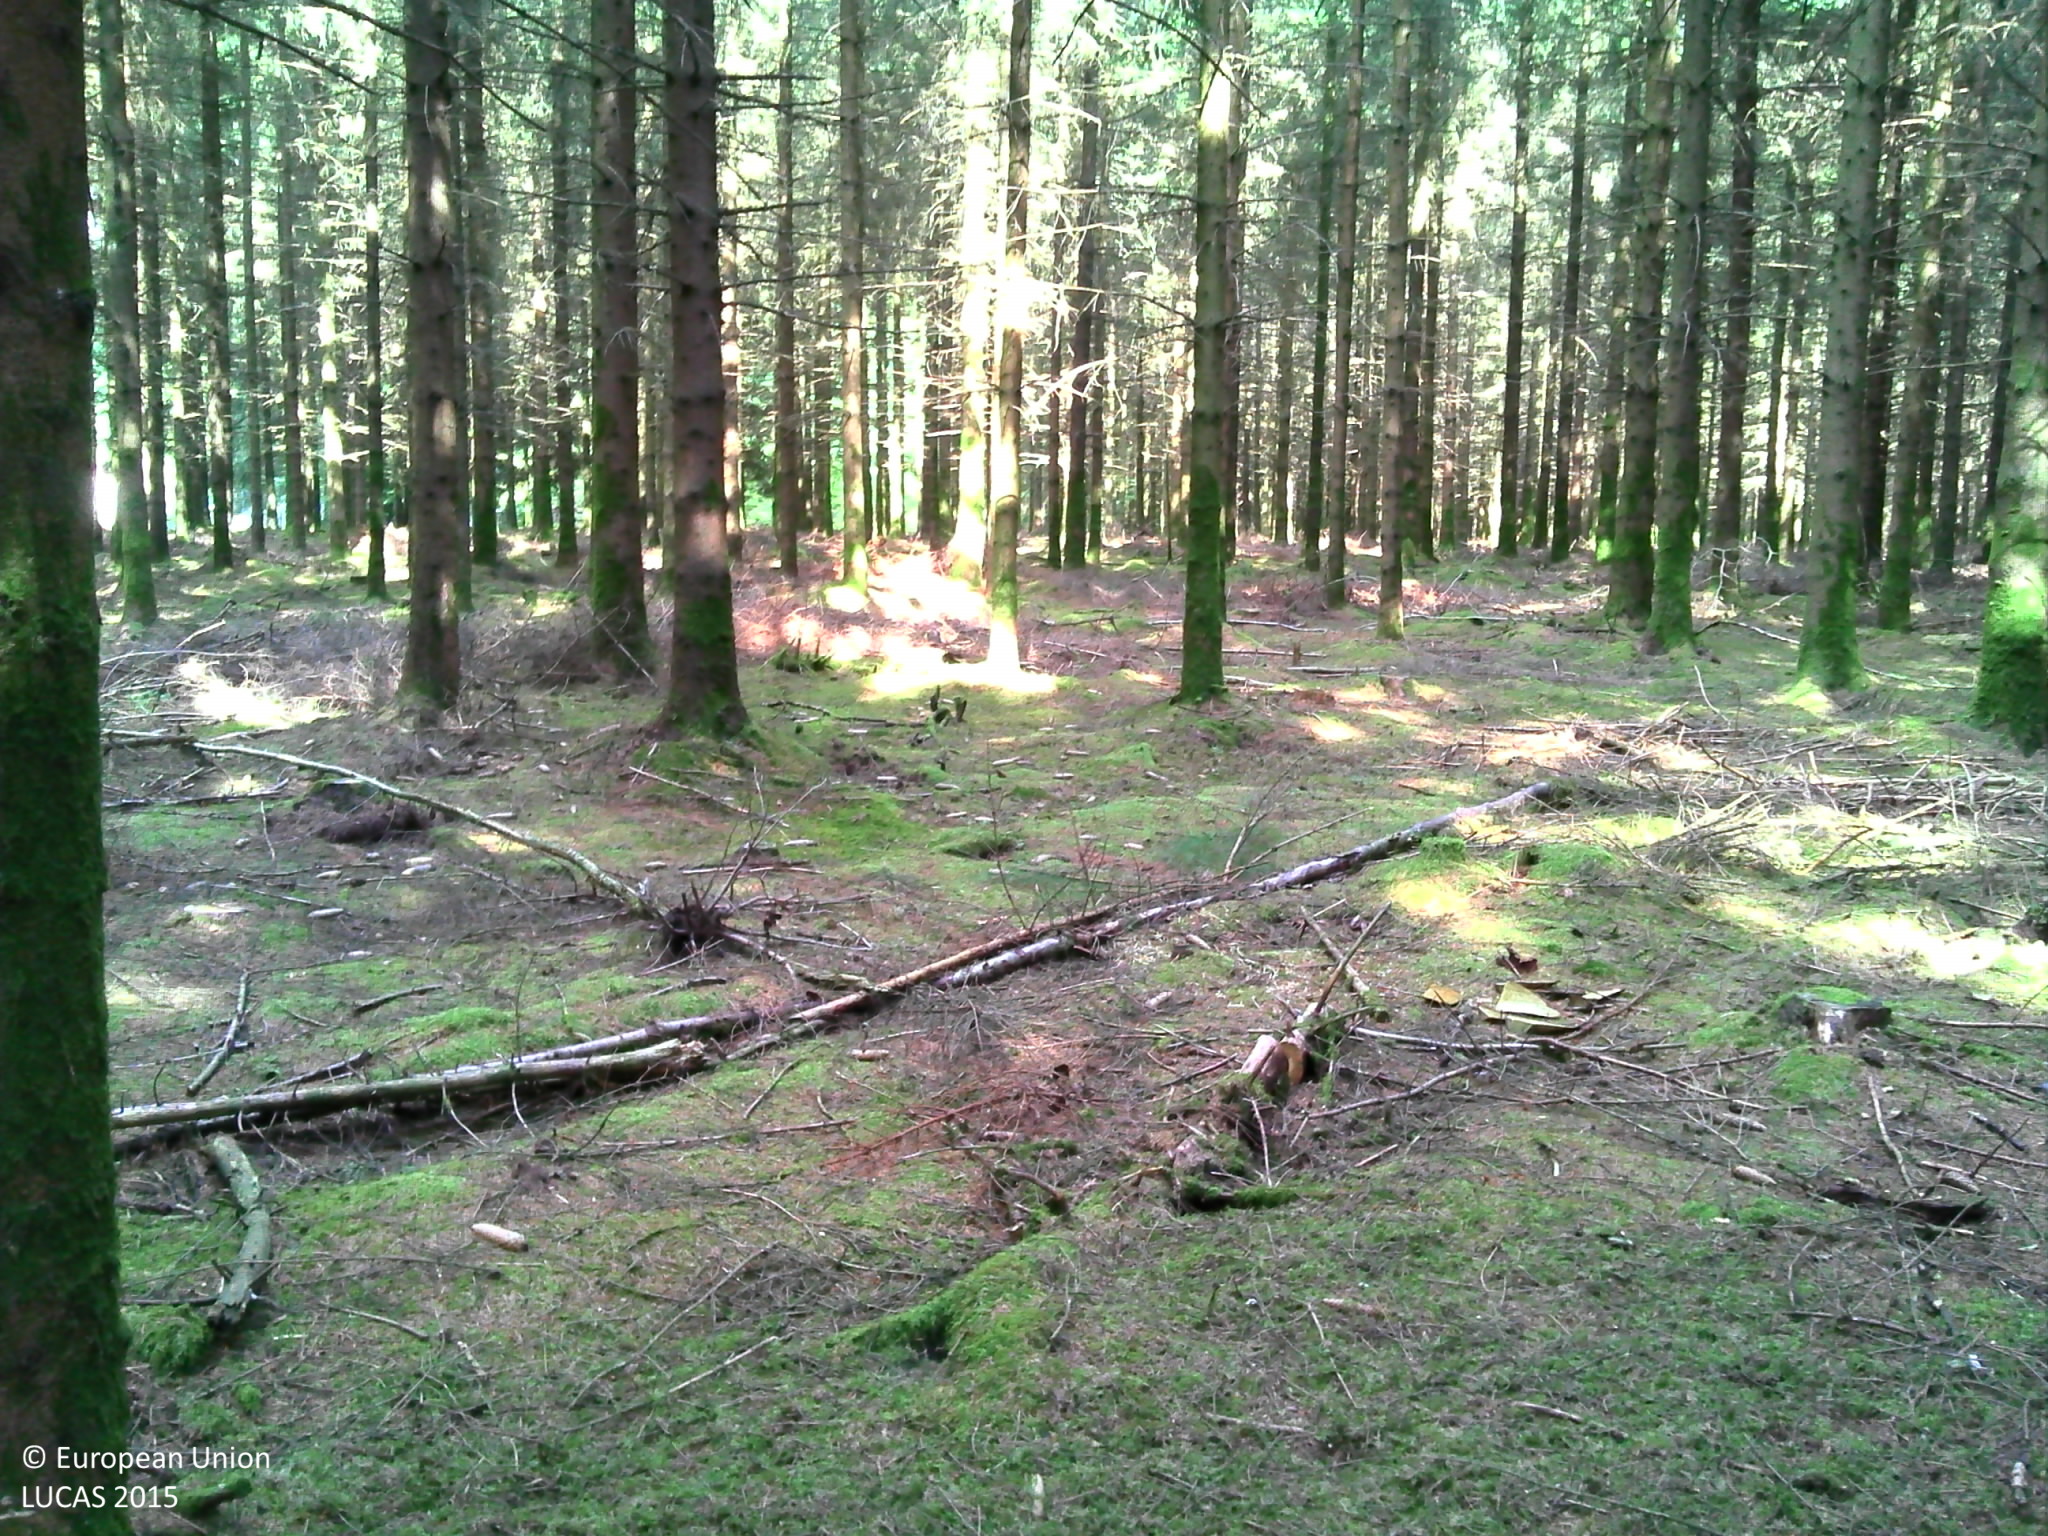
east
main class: Woodland
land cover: Spruce dominated coniferous woodland
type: hemiboreal forest and nemoral coniferous forest and mixed broadleaved-coniferous forest
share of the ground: > 75 %
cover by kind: coniferous forest trees 95 %, lichens and mosses 5 %
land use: Forestry
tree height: > 5 m
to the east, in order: Spruce dominated coniferous woodland; Artificial constructions in urban areas; Spruce dominated coniferous woodland
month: July
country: BE
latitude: 49.8447
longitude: 5.5346
